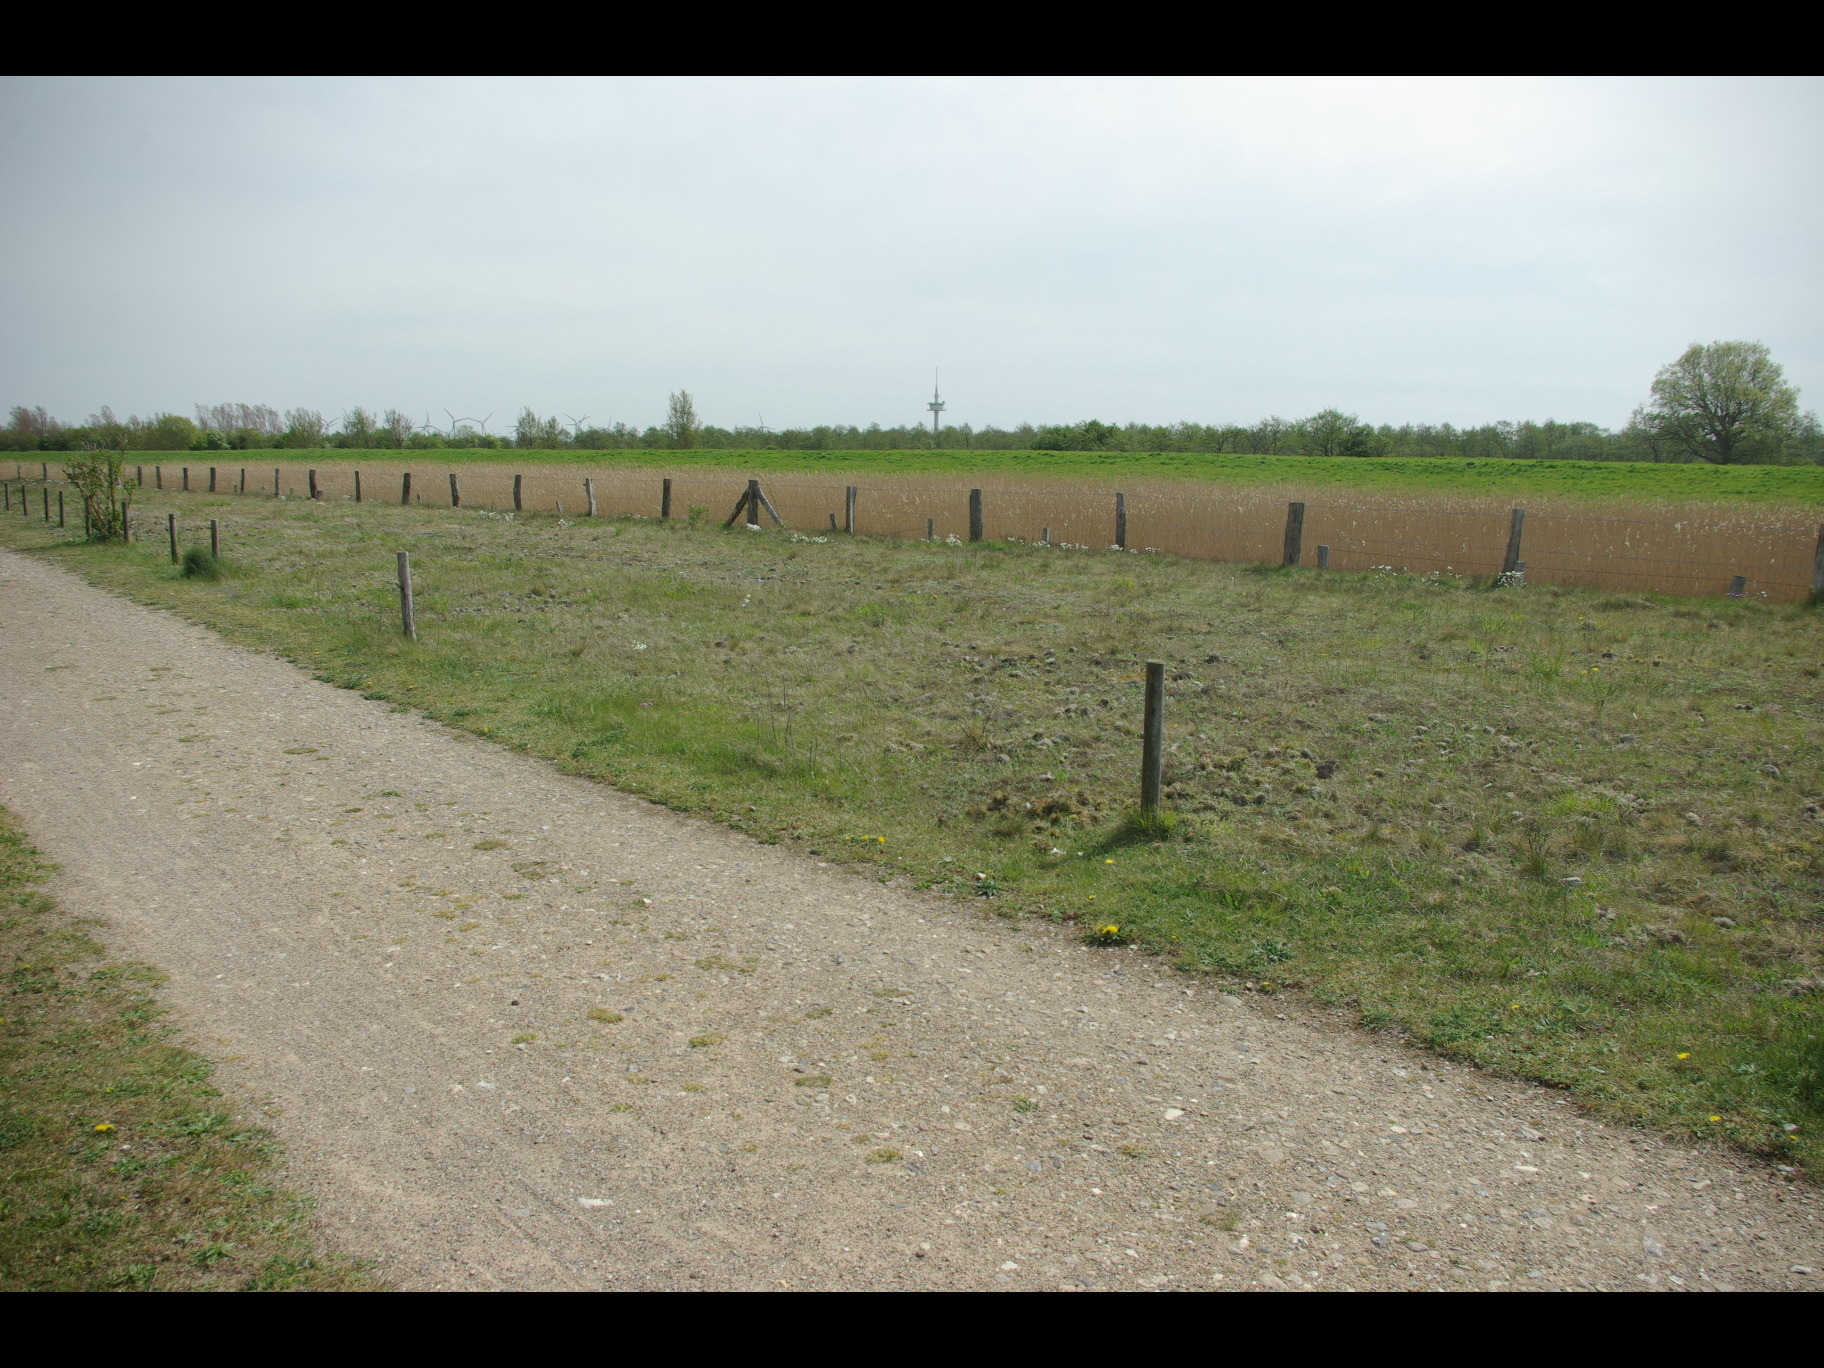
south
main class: Grassland
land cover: Grassland without tree/shrub cover
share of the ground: > 75 %
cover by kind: herbaceous plants 80 %, lichens and mosses 10 %, shrubs 5 %, unconsolidated bare surface 5 %
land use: Protection infrastructures
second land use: Agriculture (excluding fallow land and kitchen gardens)
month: May
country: DE
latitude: 54.5105
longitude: 11.1885
